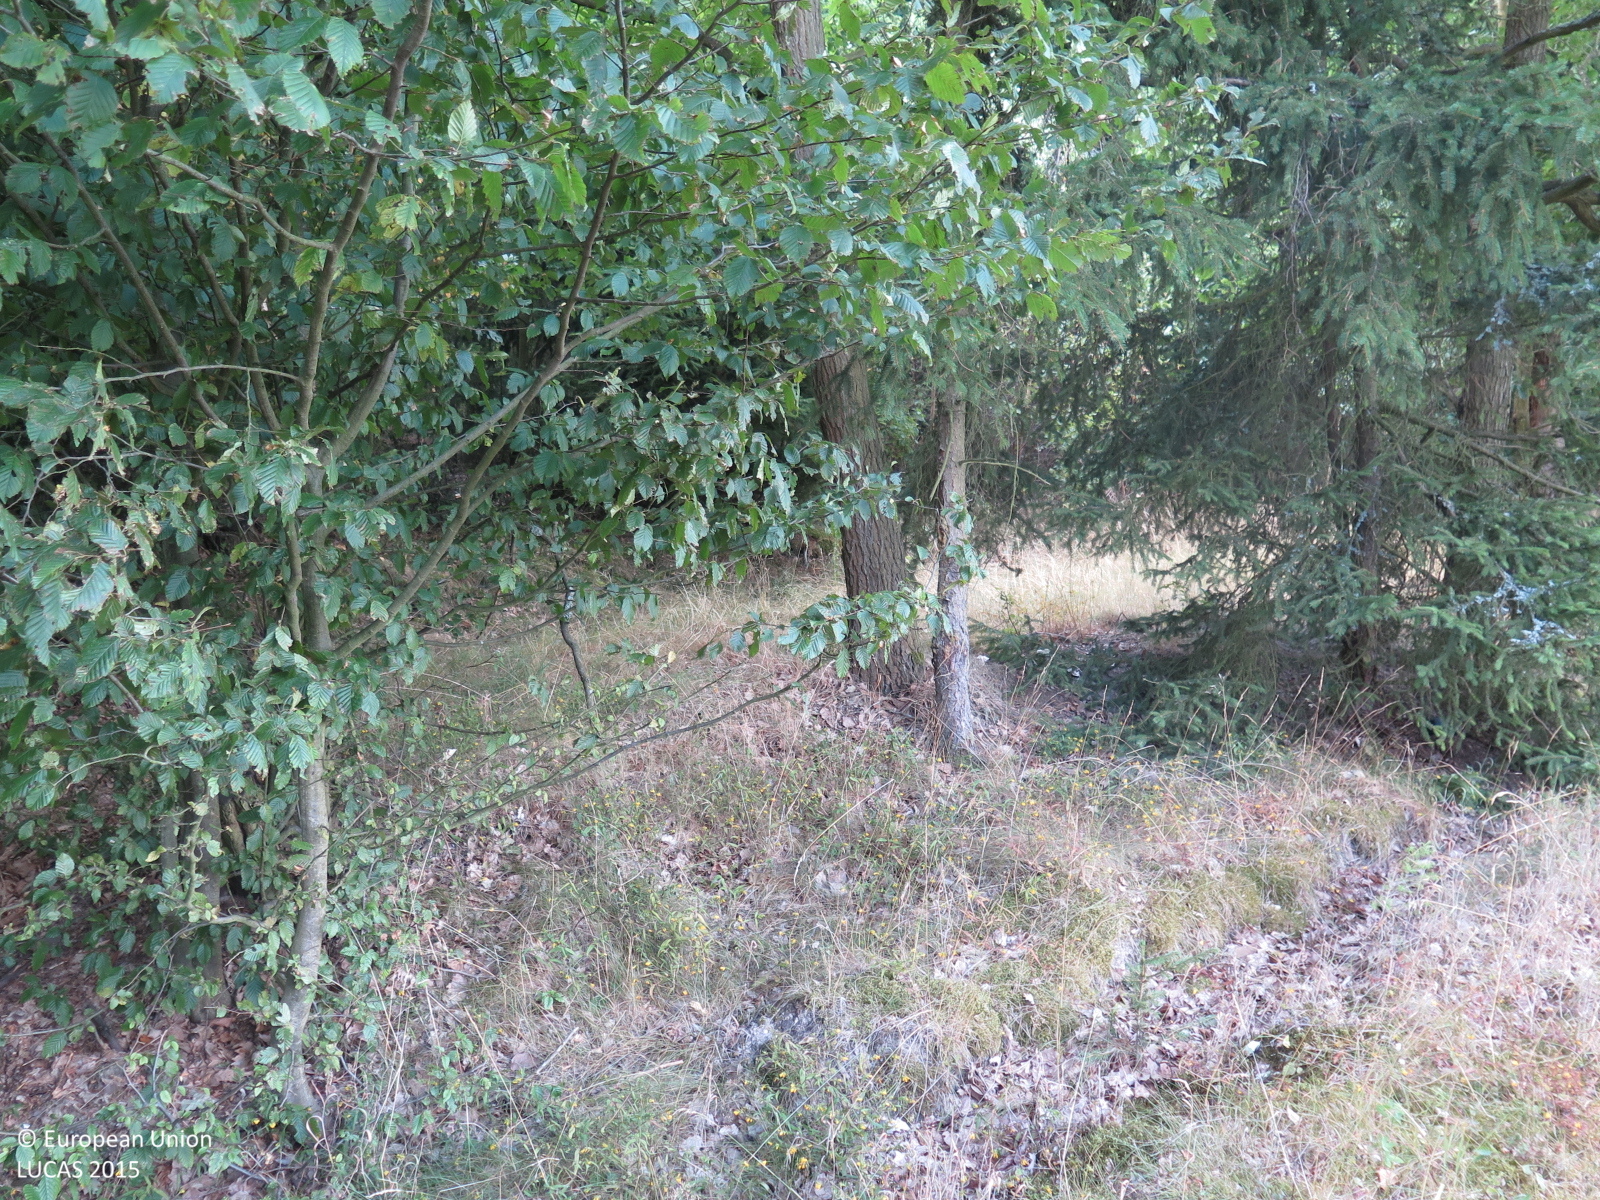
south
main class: Grassland
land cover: Grassland without tree/shrub cover
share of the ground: > 75 %
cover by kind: herbaceous plants 100 %
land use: Agriculture (excluding fallow land and kitchen gardens)
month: August
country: CZ
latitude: 50.0476
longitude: 13.8410
